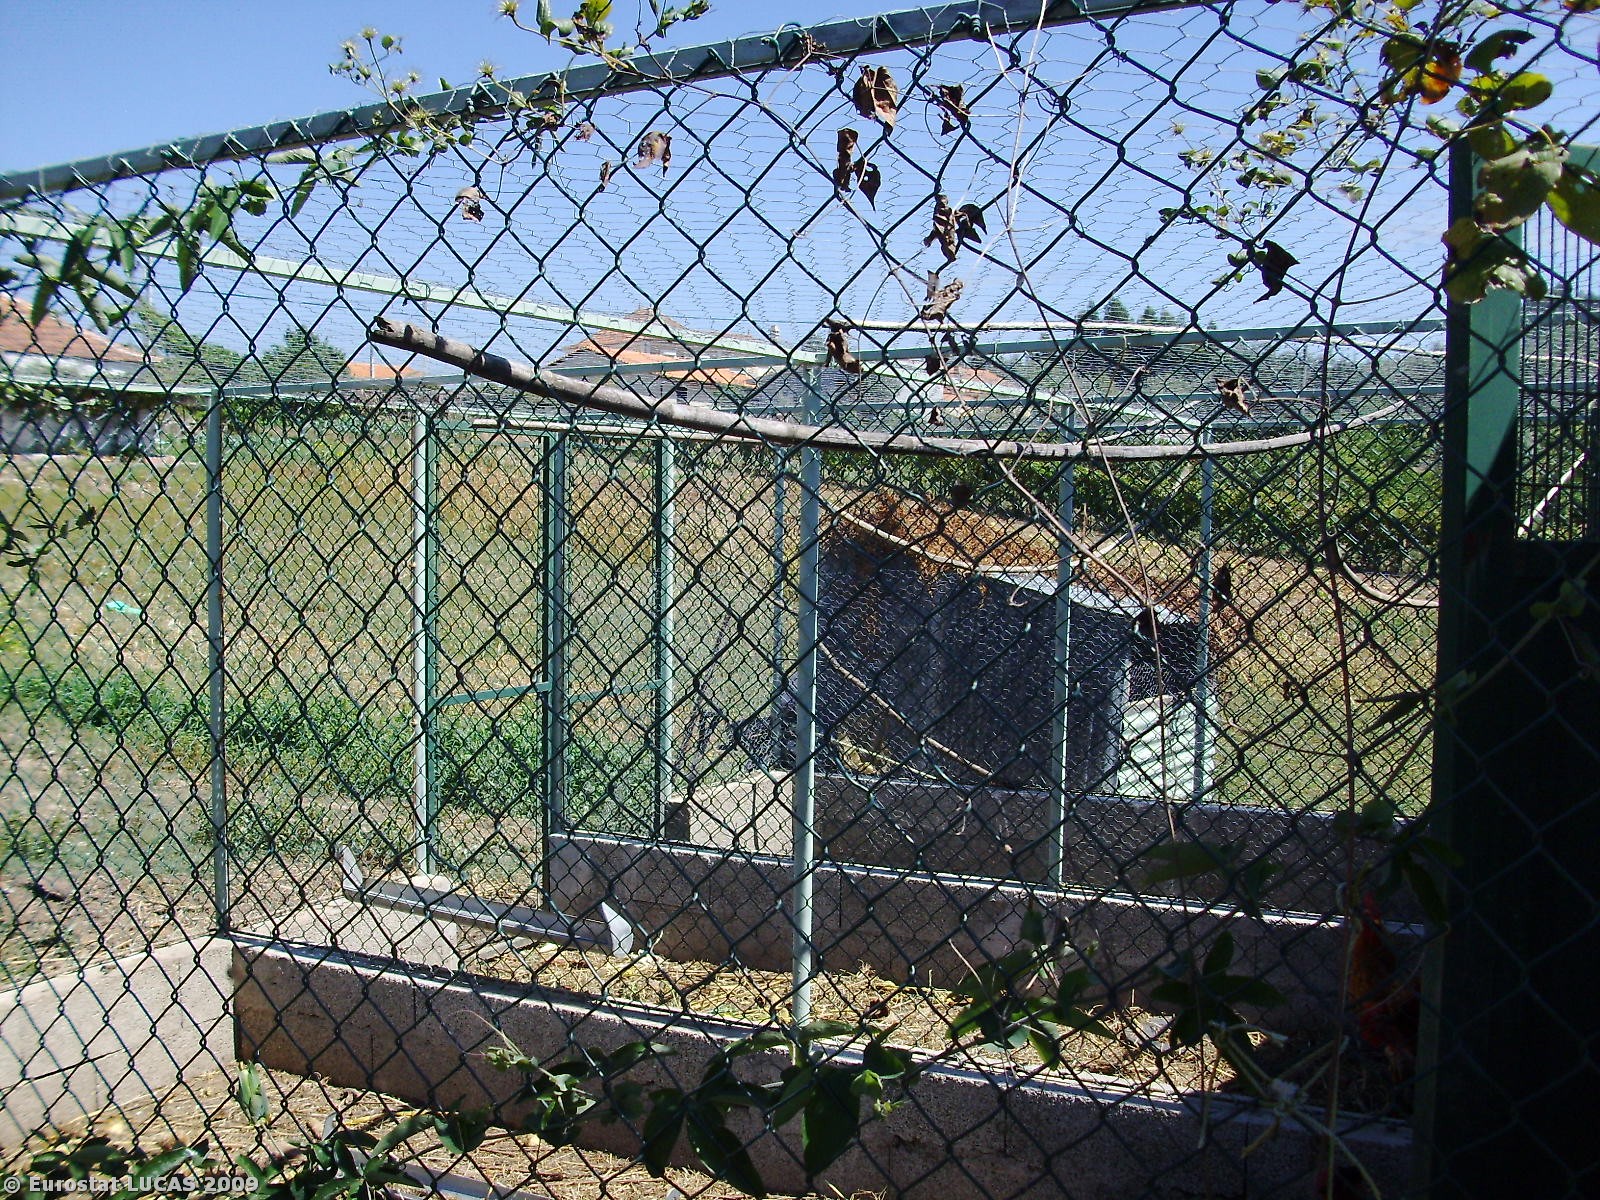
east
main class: Grassland
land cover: Spontaneously vegetated surfaces
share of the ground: > 75 %
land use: Fallow land
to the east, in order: Spontaneously vegetated surfaces; Artificial constructions in urban areas; Maize; Electric lines; Maize; Sunflower; Spontaneously vegetated surfaces; Electric lines; Spontaneously vegetated surfaces; Artificial constructions in urban areas; Paved roads, cycling and walking lanes; Electric lines; Fences; Grassland without tree/shrub cover; Olive groves; Fences; Vineyards; Shrubland with sparse tree cover
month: August
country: PT
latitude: 40.1894
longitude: -8.2248
